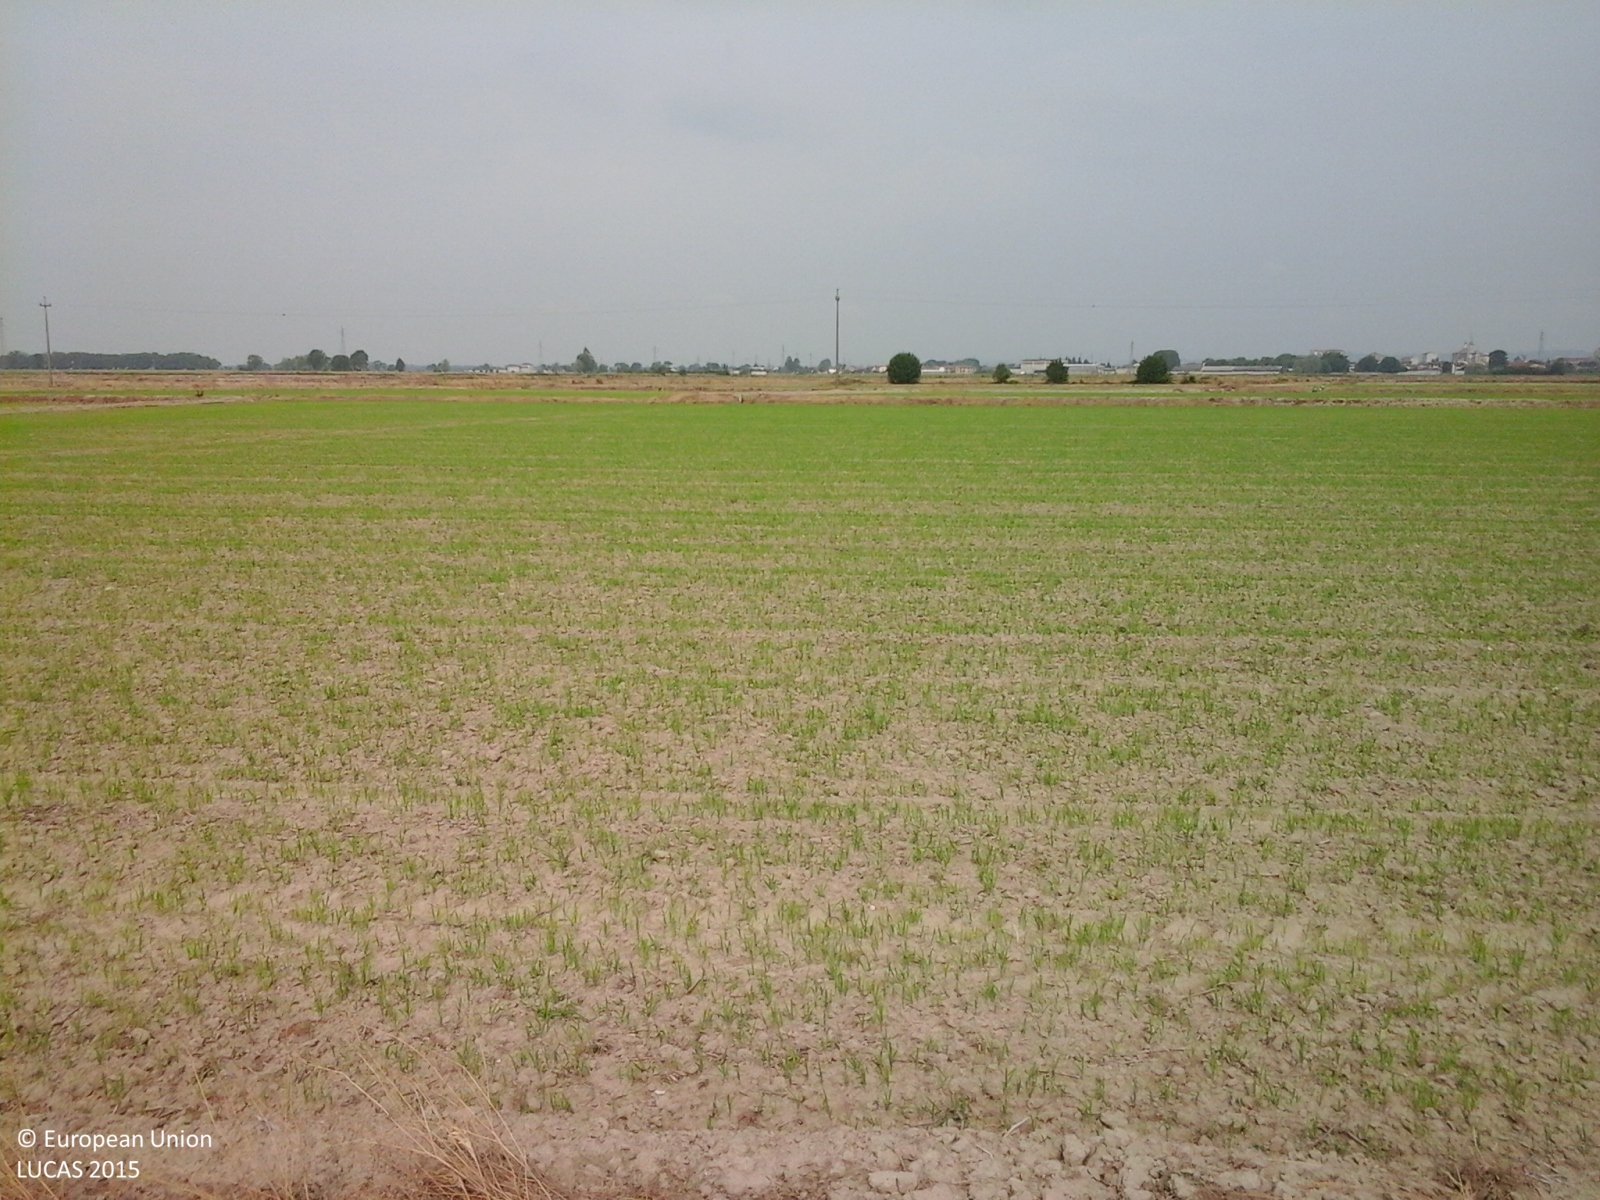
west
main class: Cropland
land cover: Rice
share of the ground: < 10 %
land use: Agriculture (excluding fallow land and kitchen gardens)
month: May
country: IT
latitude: 45.2711
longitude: 8.1041
